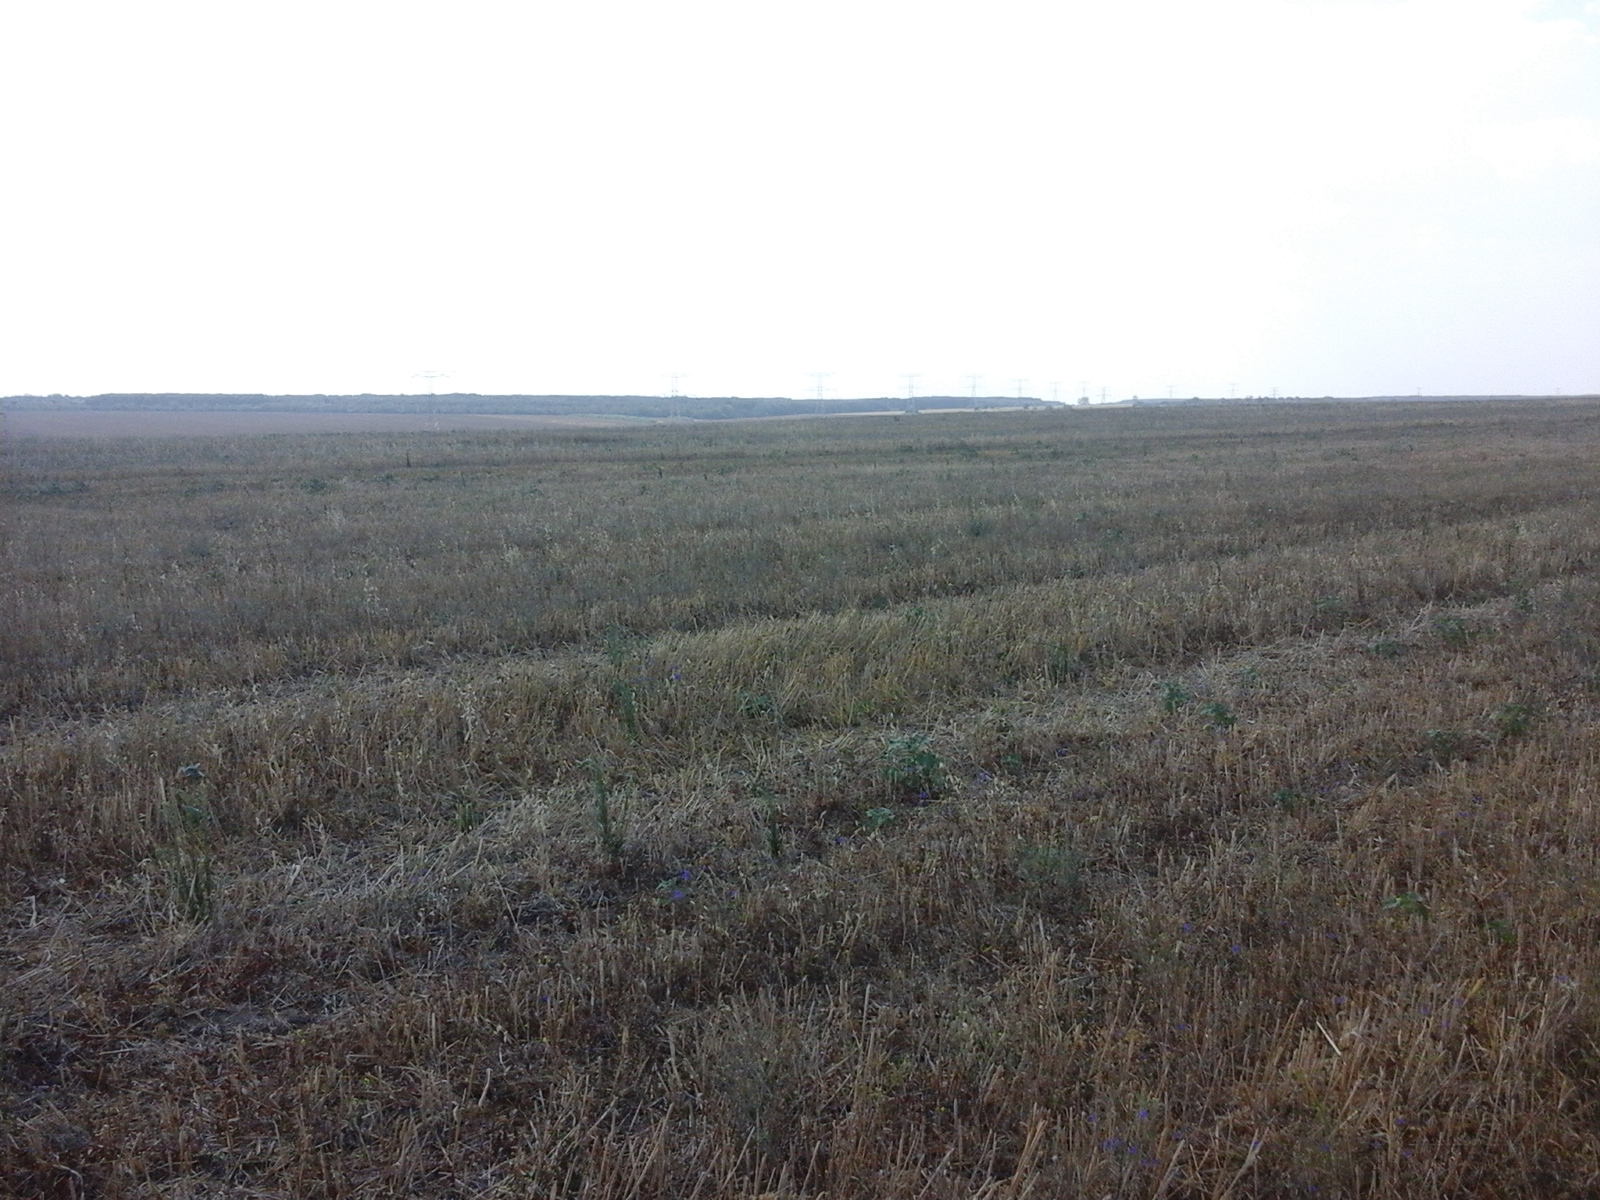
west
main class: Cropland
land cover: Oats
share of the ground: > 75 %
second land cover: Spontaneously vegetated surfaces
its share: 10 - 25 %
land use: Agriculture (excluding fallow land and kitchen gardens)
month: August
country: RO
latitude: 44.1668
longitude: 23.5706
